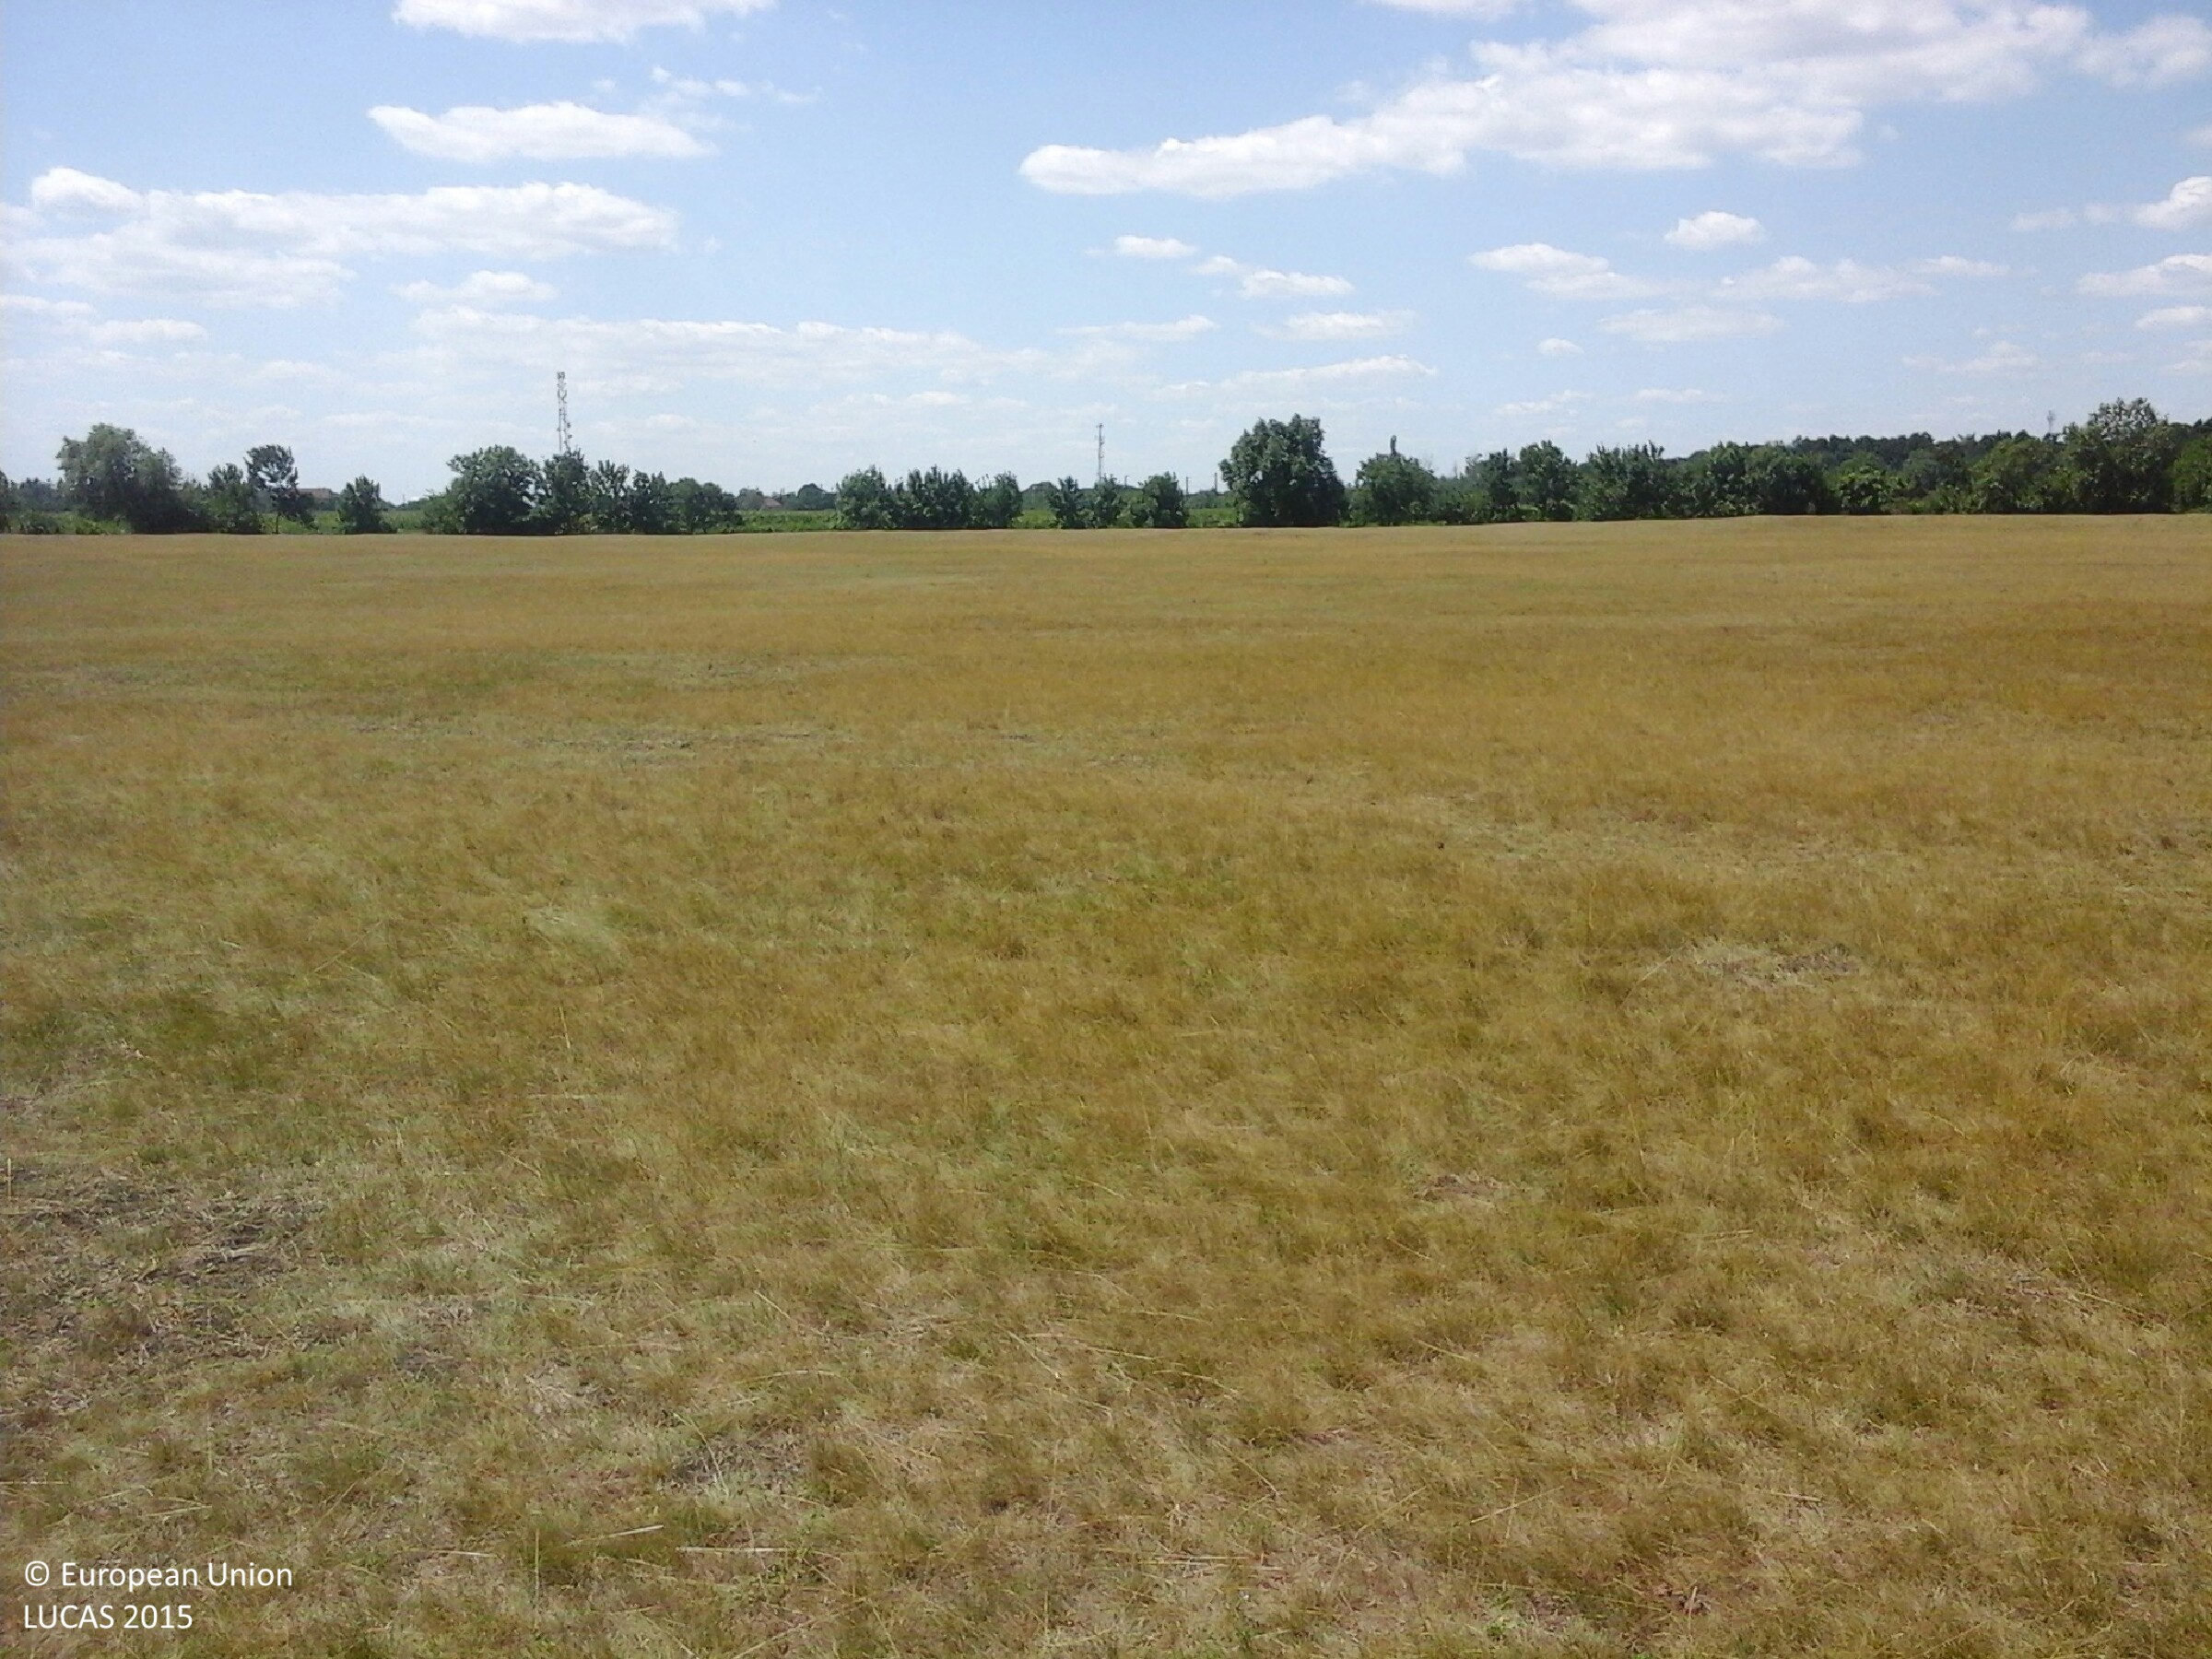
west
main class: Grassland
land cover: Grassland without tree/shrub cover
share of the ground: > 75 %
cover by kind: herbaceous plants 95 %, unconsolidated bare surface 5 %
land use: Agriculture (excluding fallow land and kitchen gardens)
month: July
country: HU
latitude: 47.8479
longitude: 20.6852
